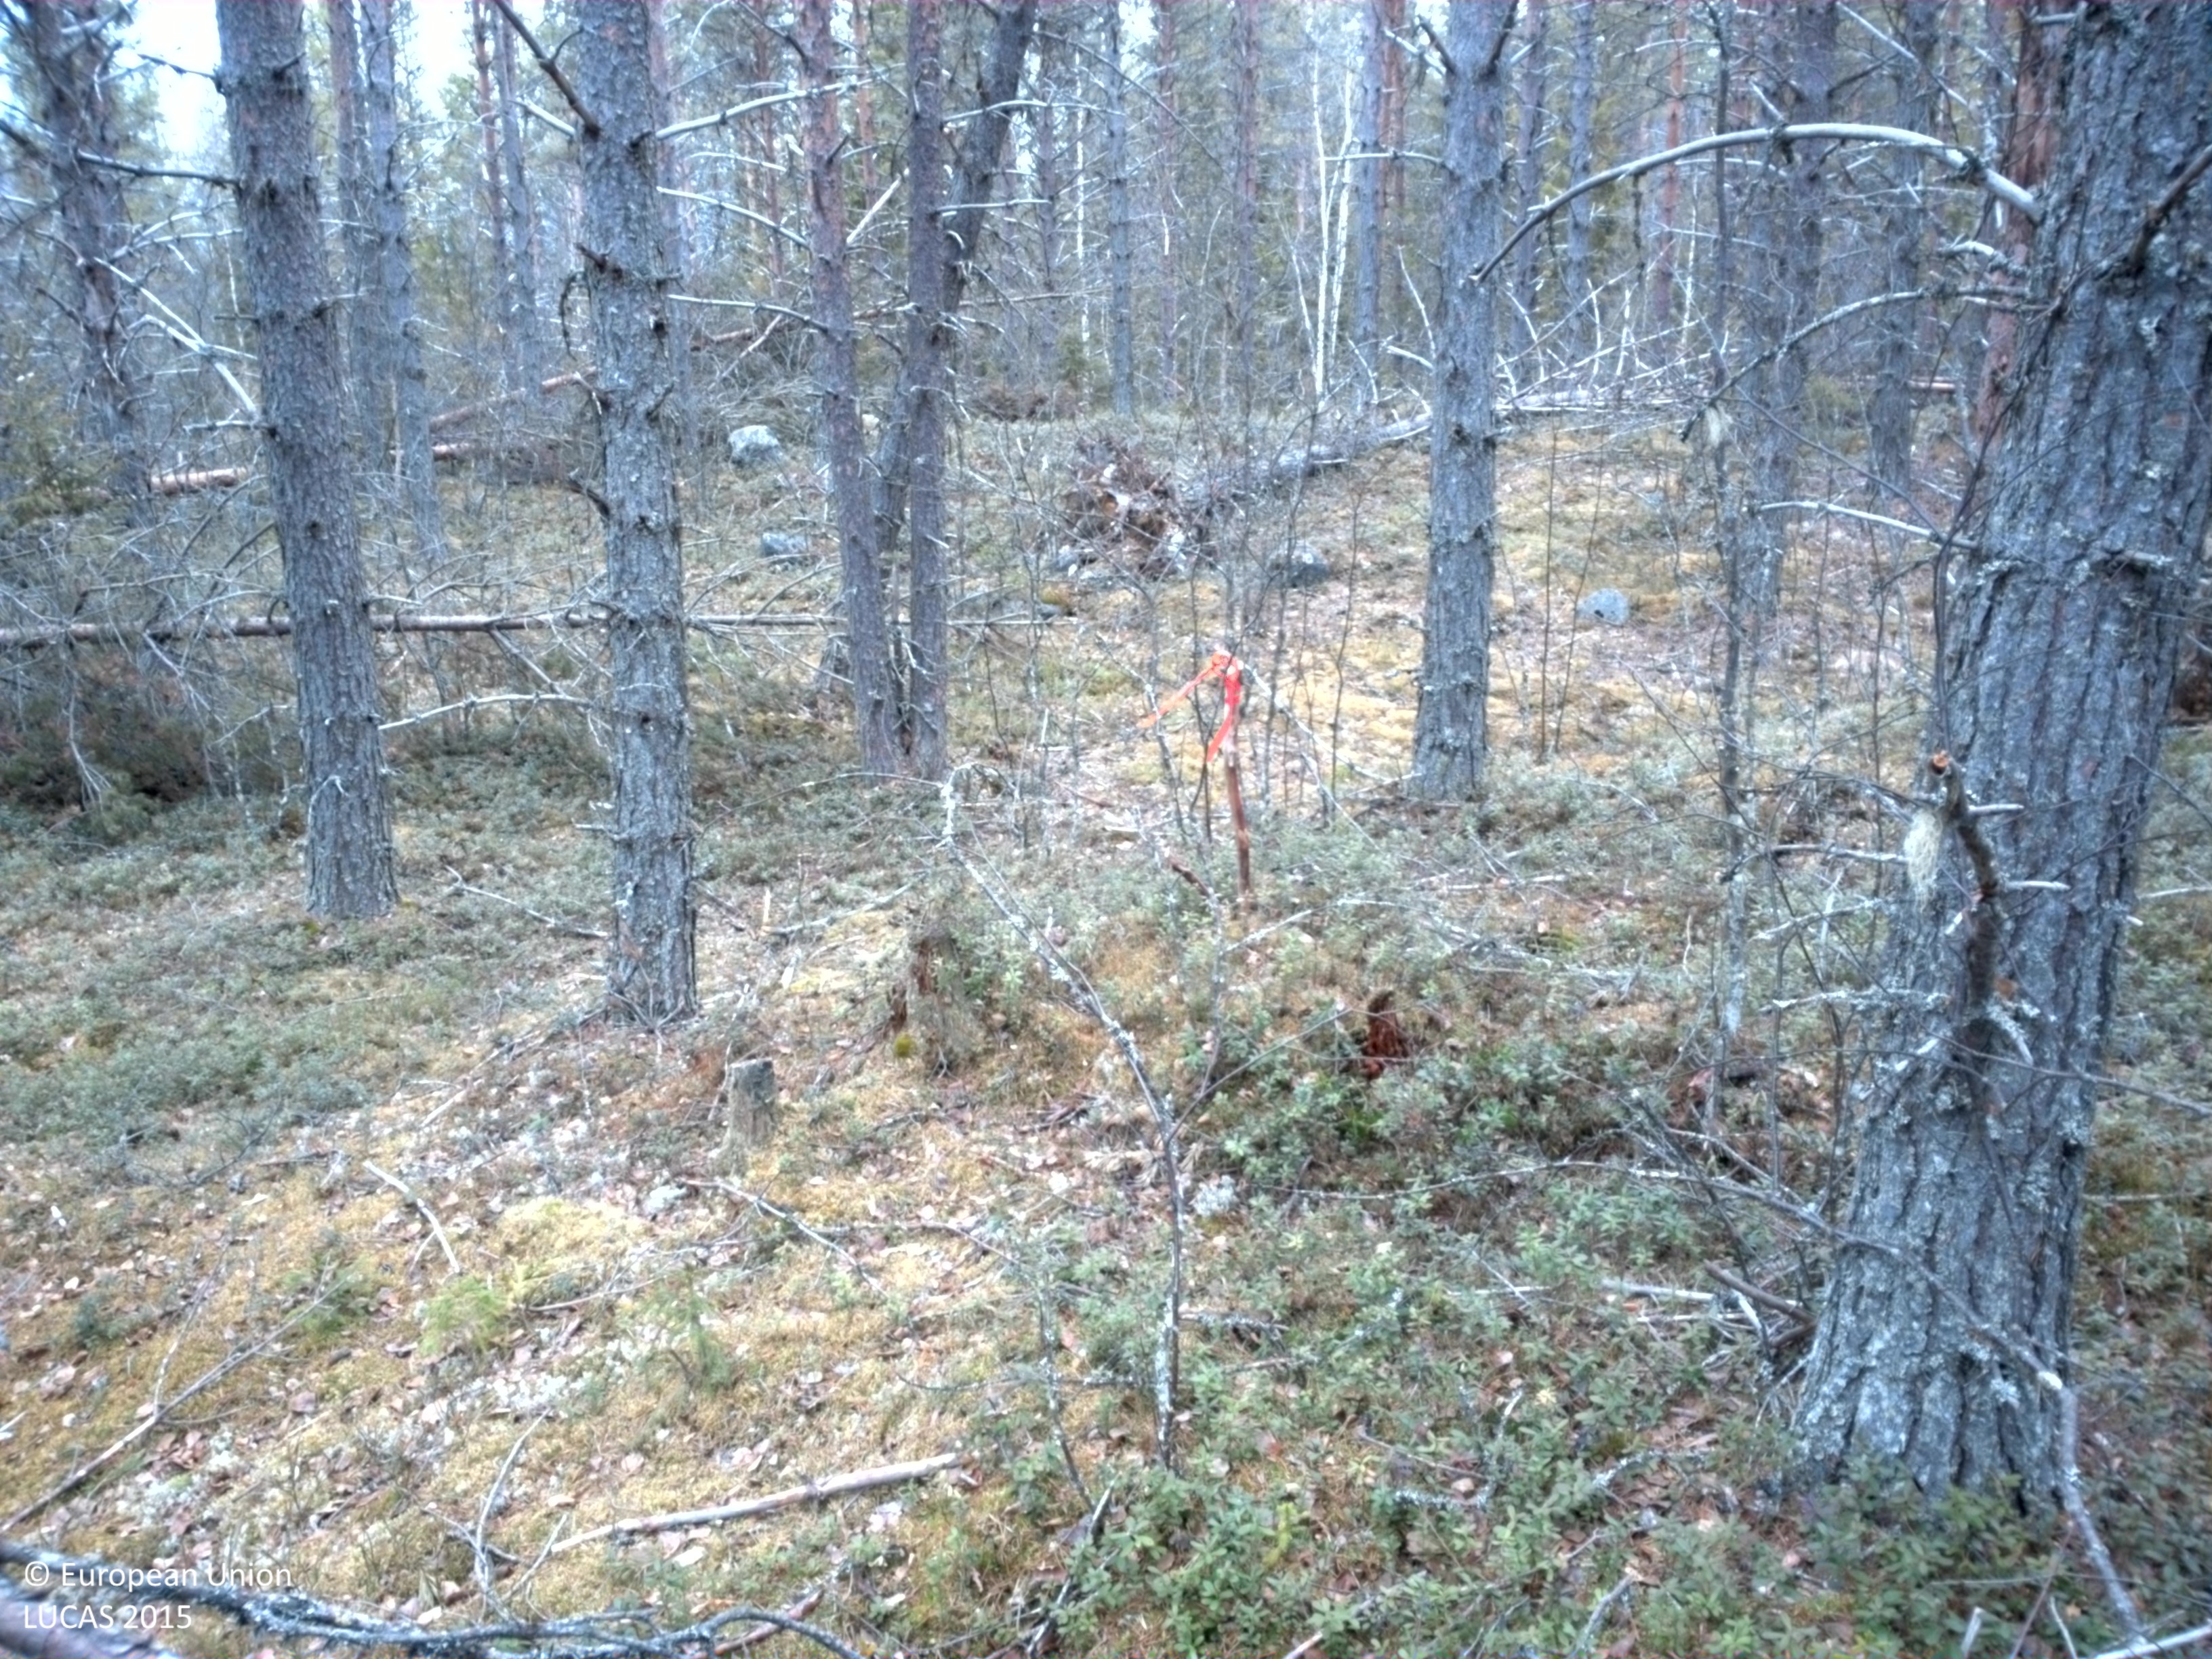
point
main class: Woodland
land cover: Pine dominated coniferous woodland
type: boreal forest
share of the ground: 25 - 50 %
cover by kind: coniferous forest trees 40 %, lichens and mosses 30 %, herbaceous plants 20 %, broadleaved forest trees 10 %
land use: Forestry
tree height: > 5 m
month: May
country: SE
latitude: 64.2943
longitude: 18.2141
